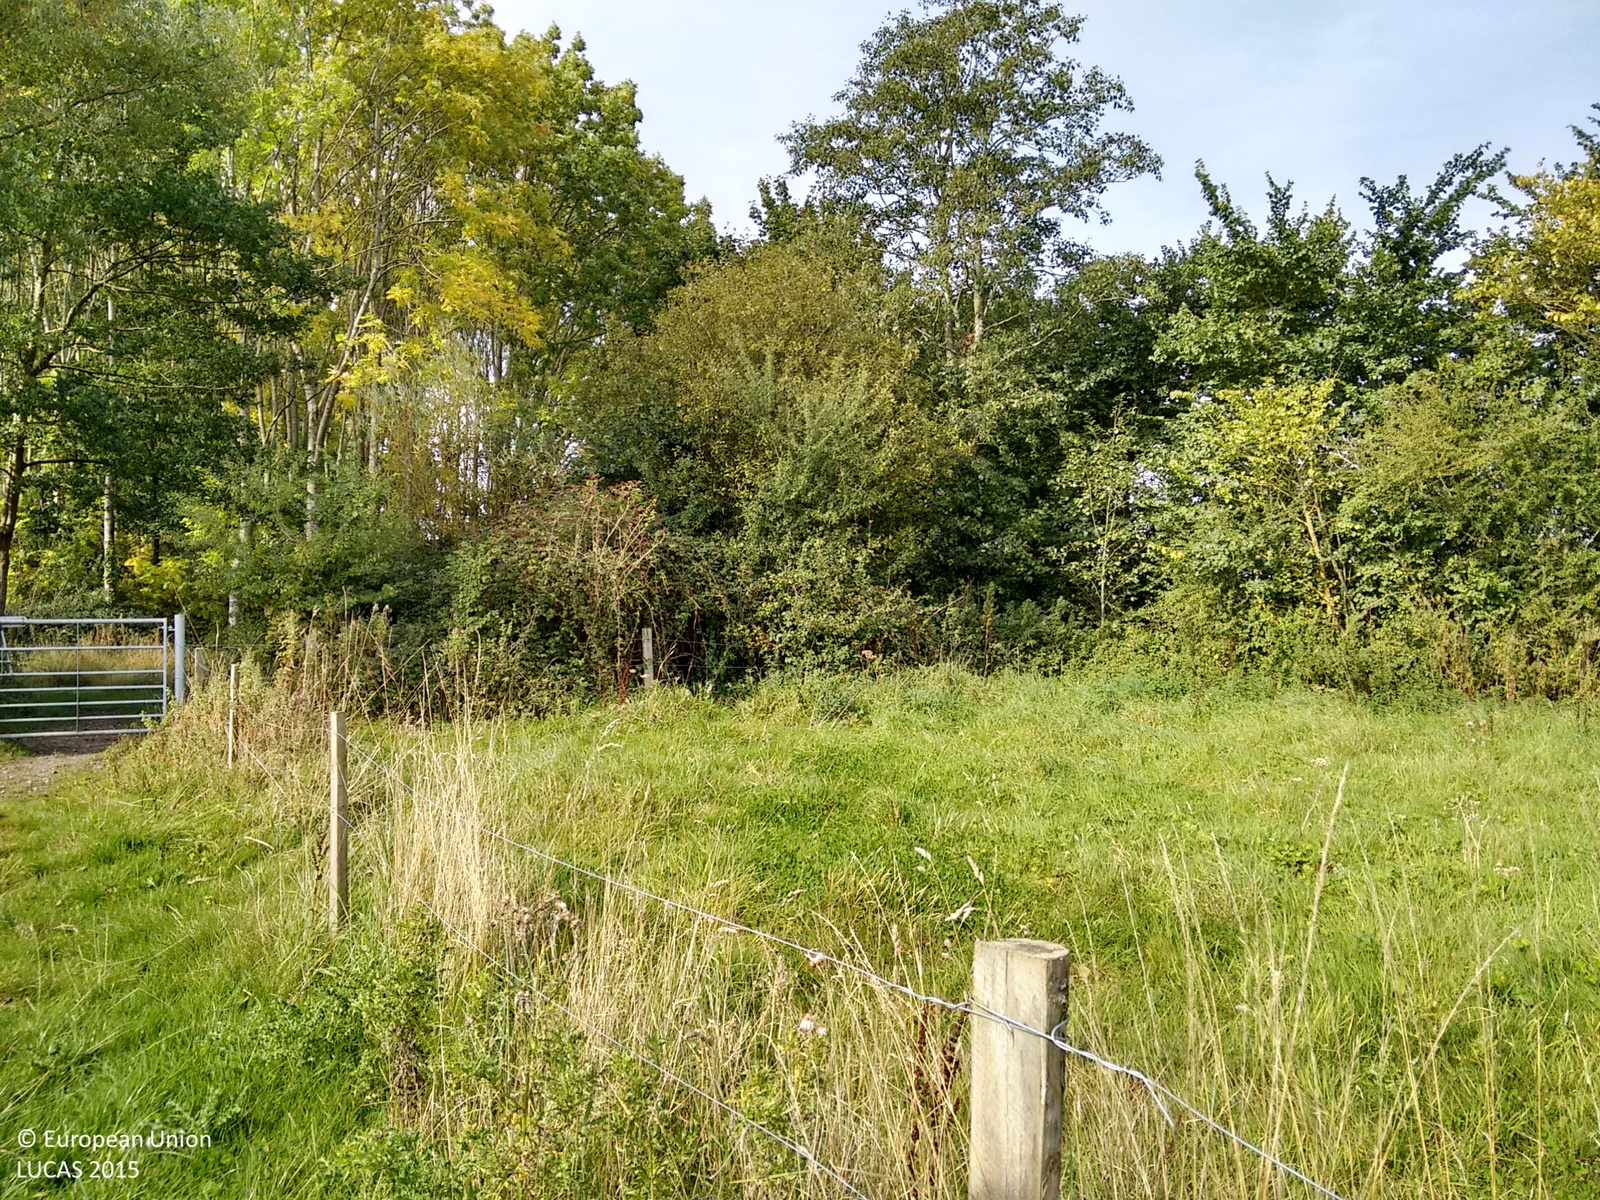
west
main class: Grassland
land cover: Grassland without tree/shrub cover
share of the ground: > 75 %
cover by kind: herbaceous plants 100 %
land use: Agriculture (excluding fallow land and kitchen gardens)
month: September
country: GB
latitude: 51.6521
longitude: -2.3938
